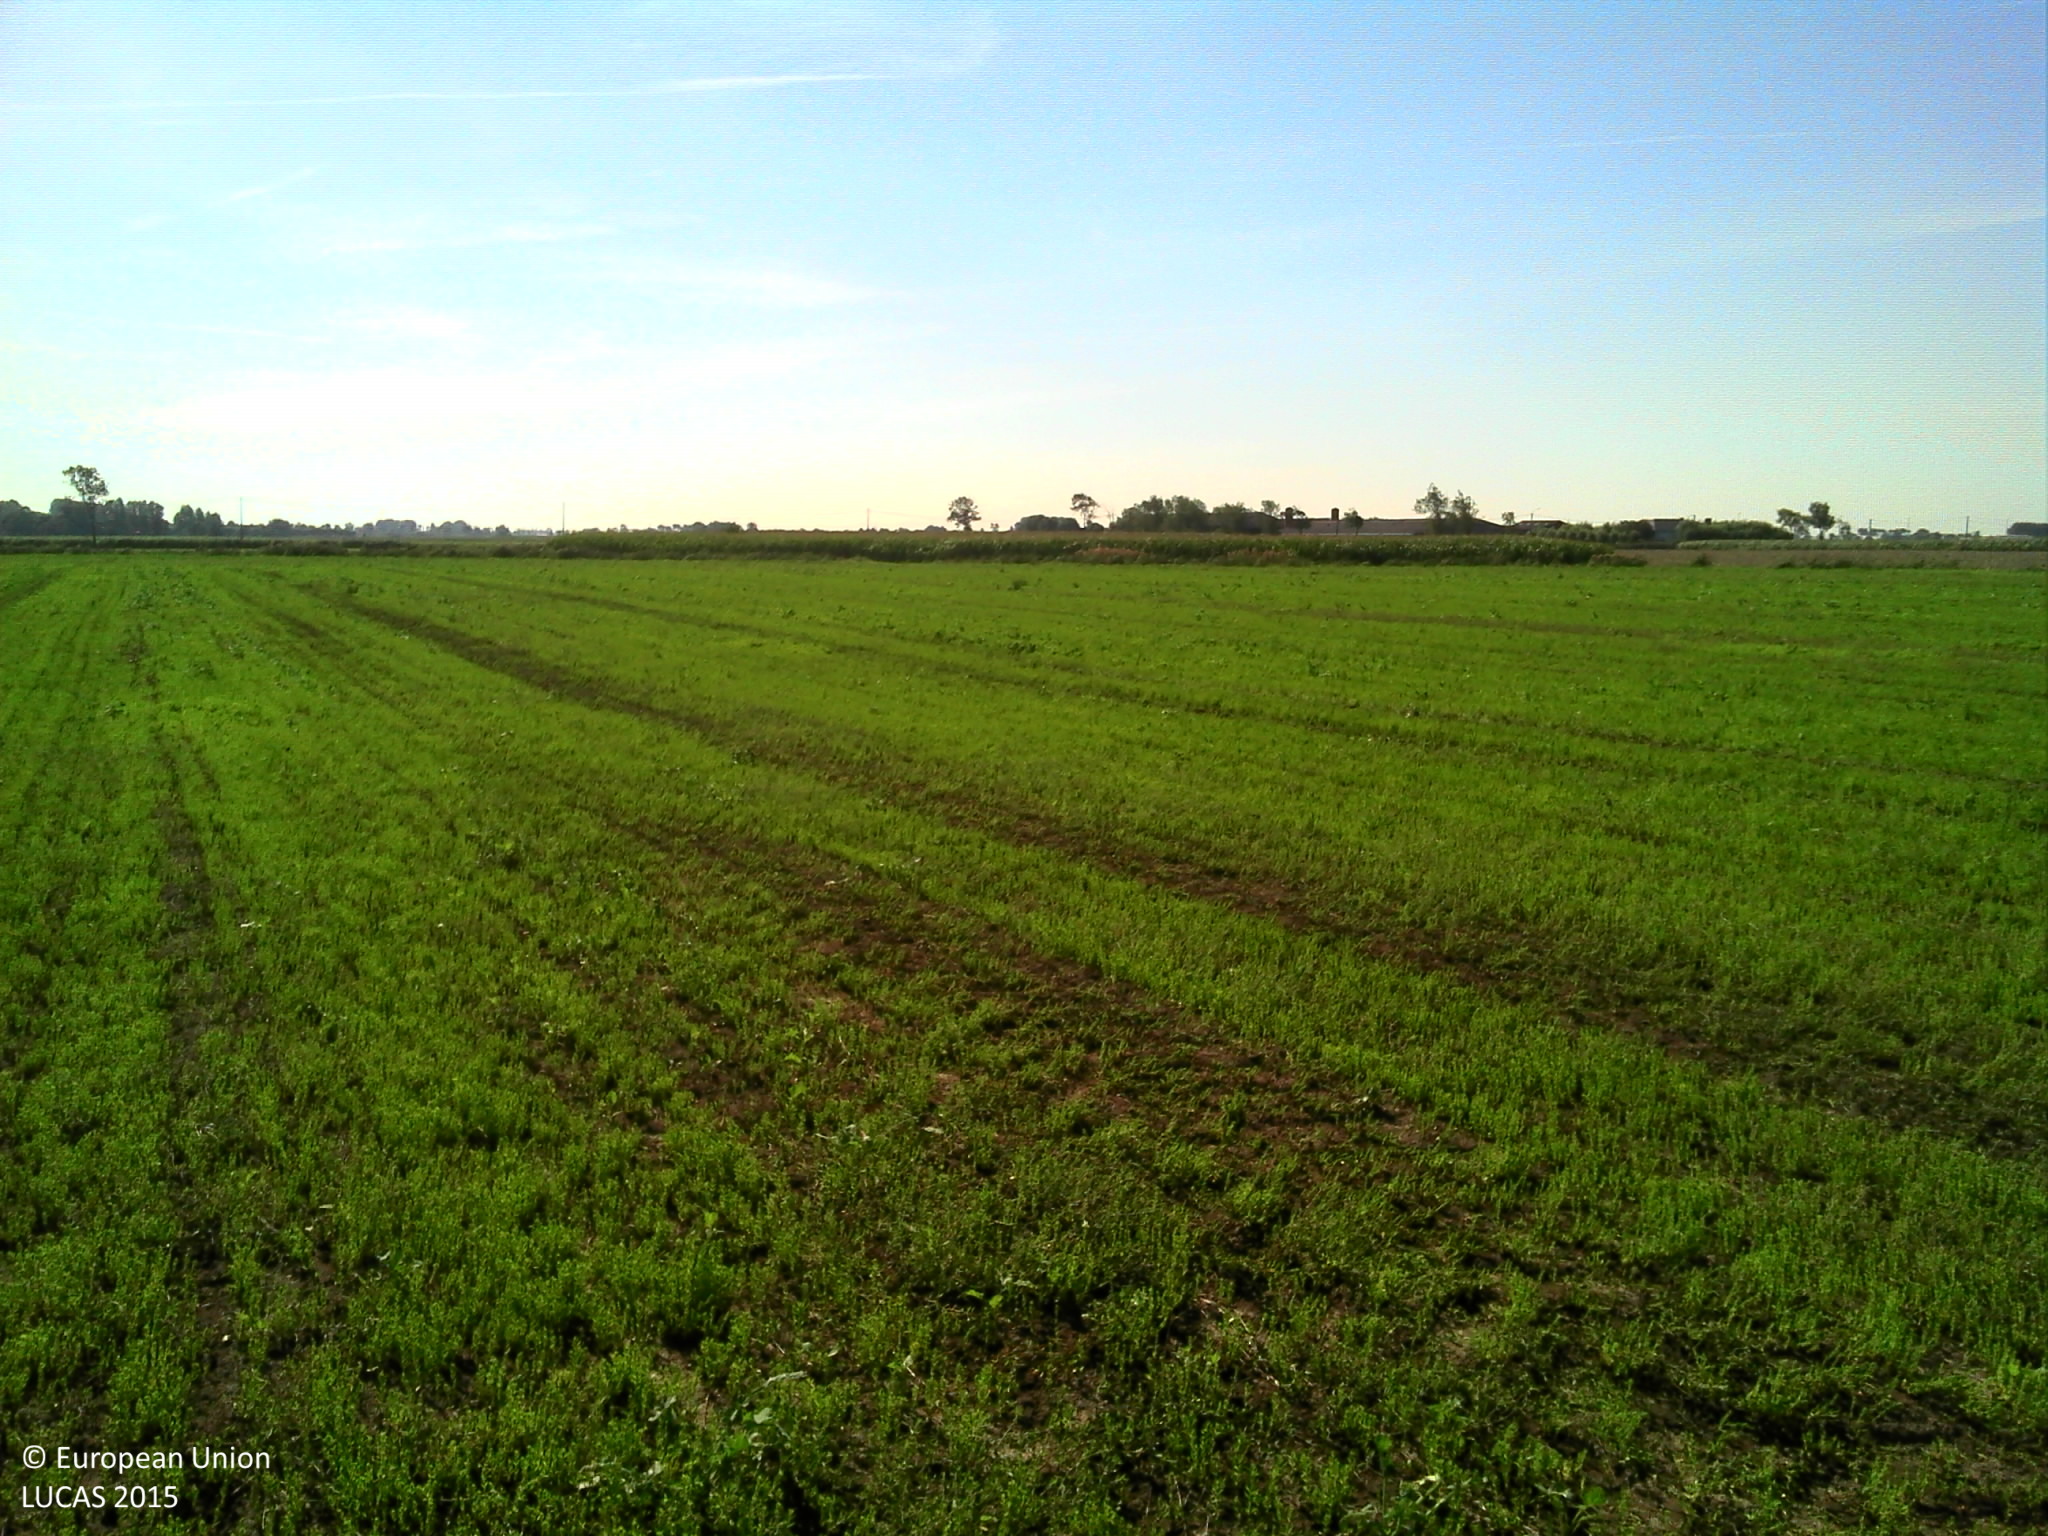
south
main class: Cropland
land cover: Other fibre and oleaginous crops
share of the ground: 50 - 75 %
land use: Agriculture (excluding fallow land and kitchen gardens)
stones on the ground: < 10 %
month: September
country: BE
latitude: 51.1872
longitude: 2.8497
